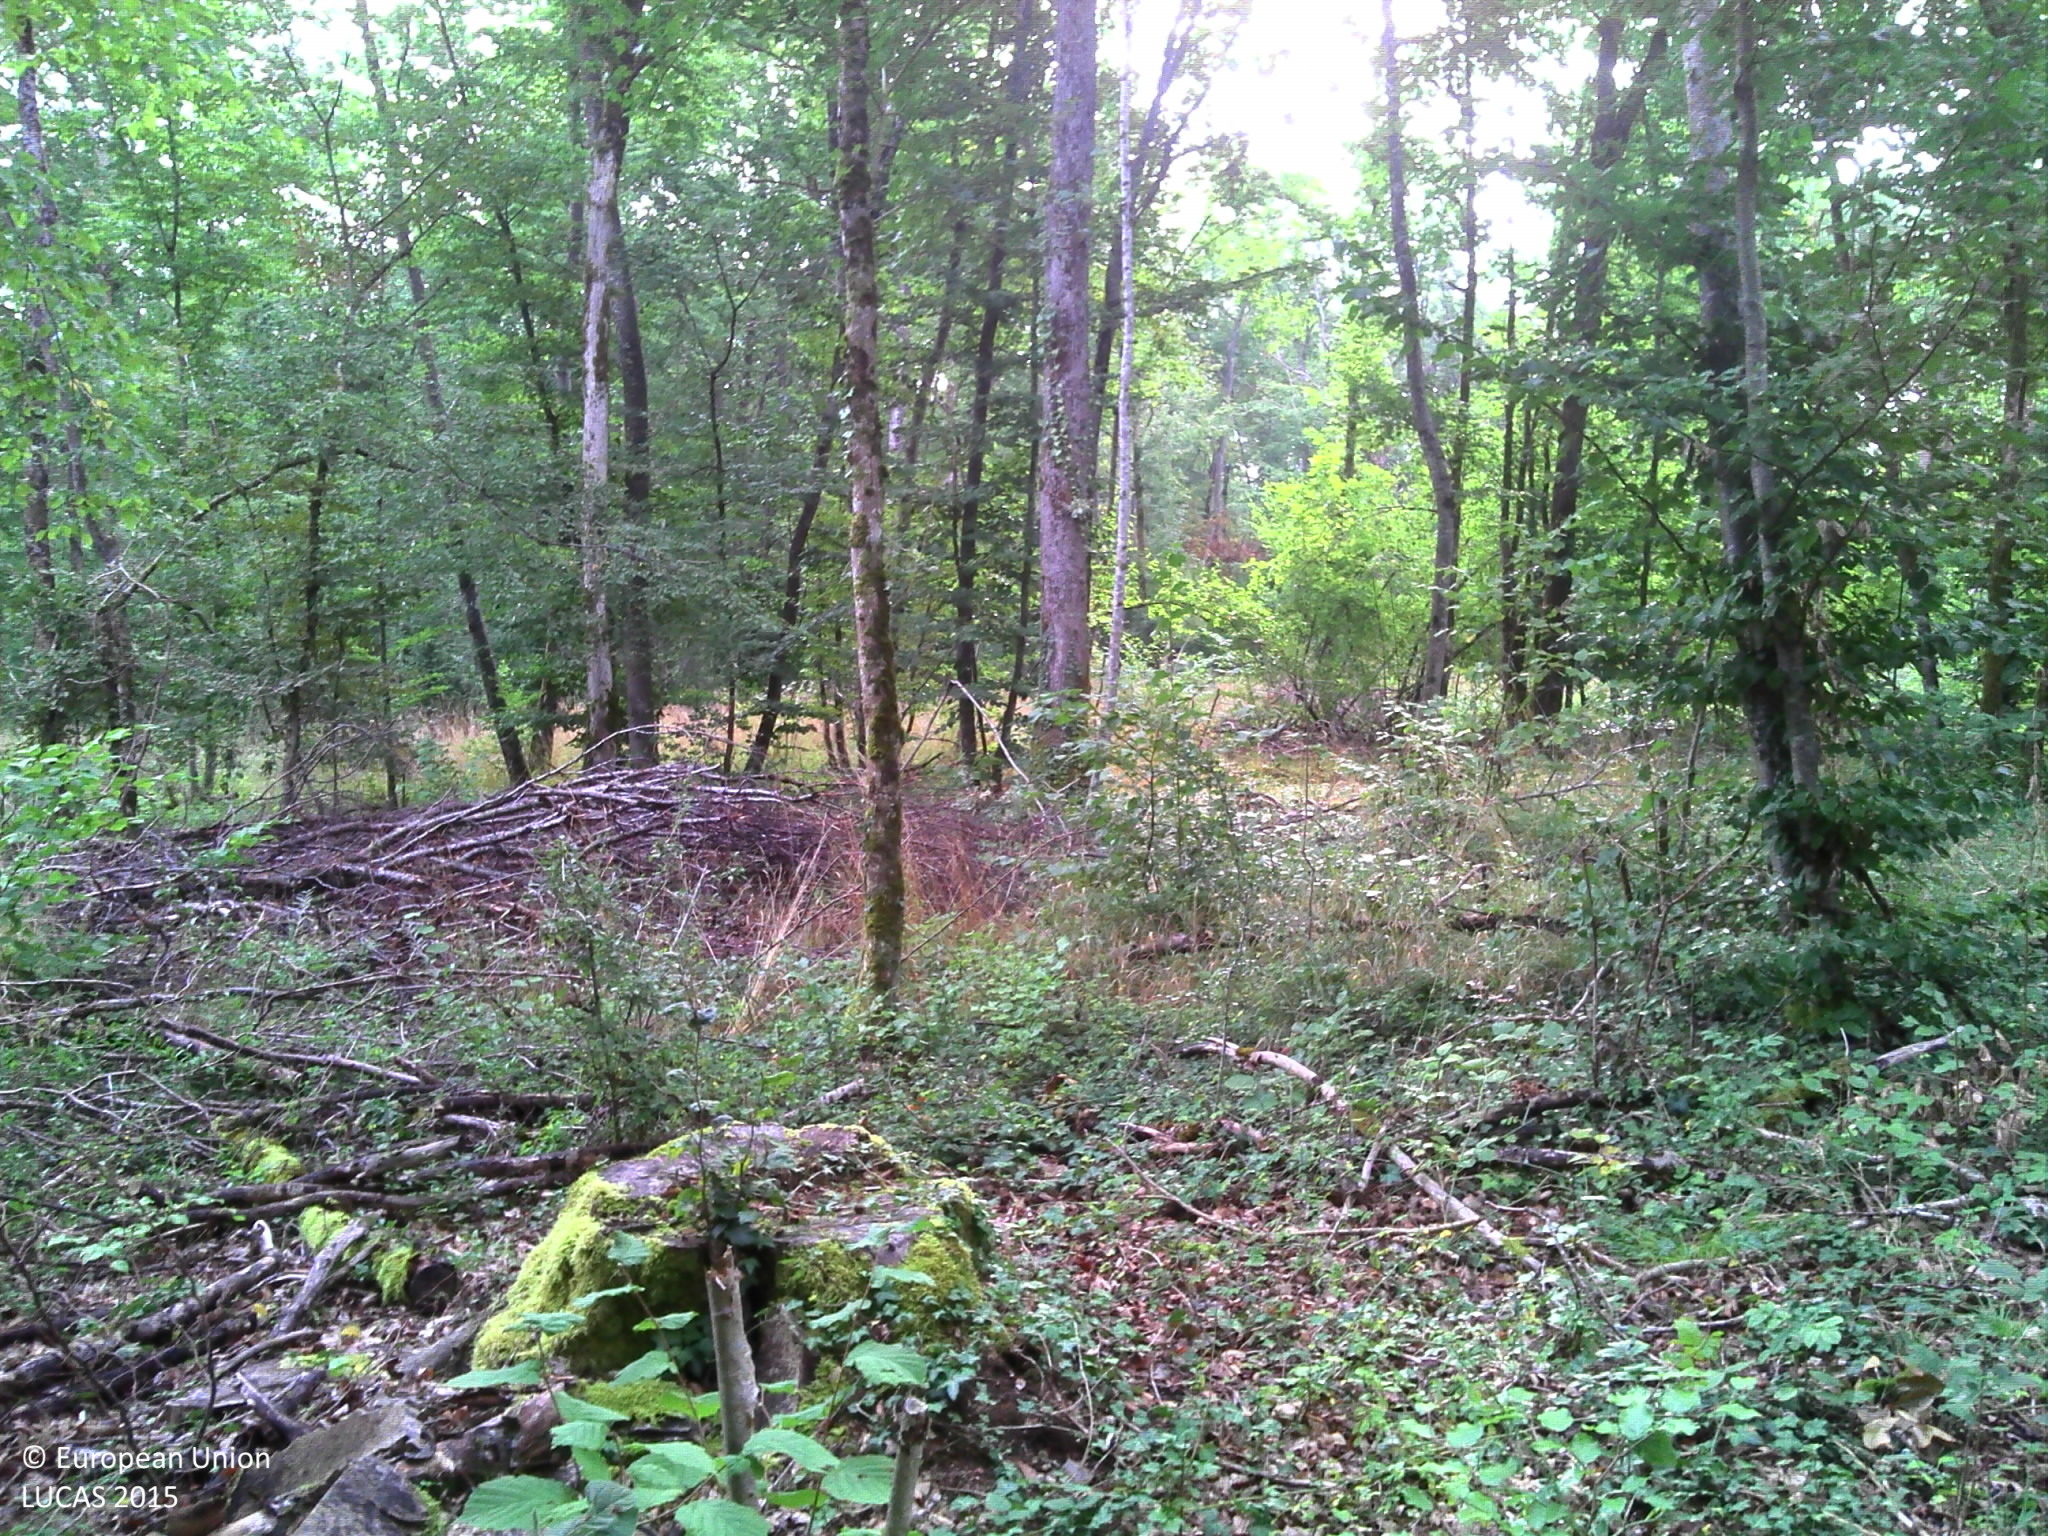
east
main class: Woodland
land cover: Broadleaved woodland
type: mesophytic deciduous forest
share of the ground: > 75 %
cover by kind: broadleaved forest trees 90 %, herbaceous plants 5 %, lichens and mosses 5 %
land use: Forestry
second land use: Amenities, museums, leisure
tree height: > 5 m
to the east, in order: Broadleaved woodland
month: September
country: FR
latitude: 47.6343
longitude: 4.8489
